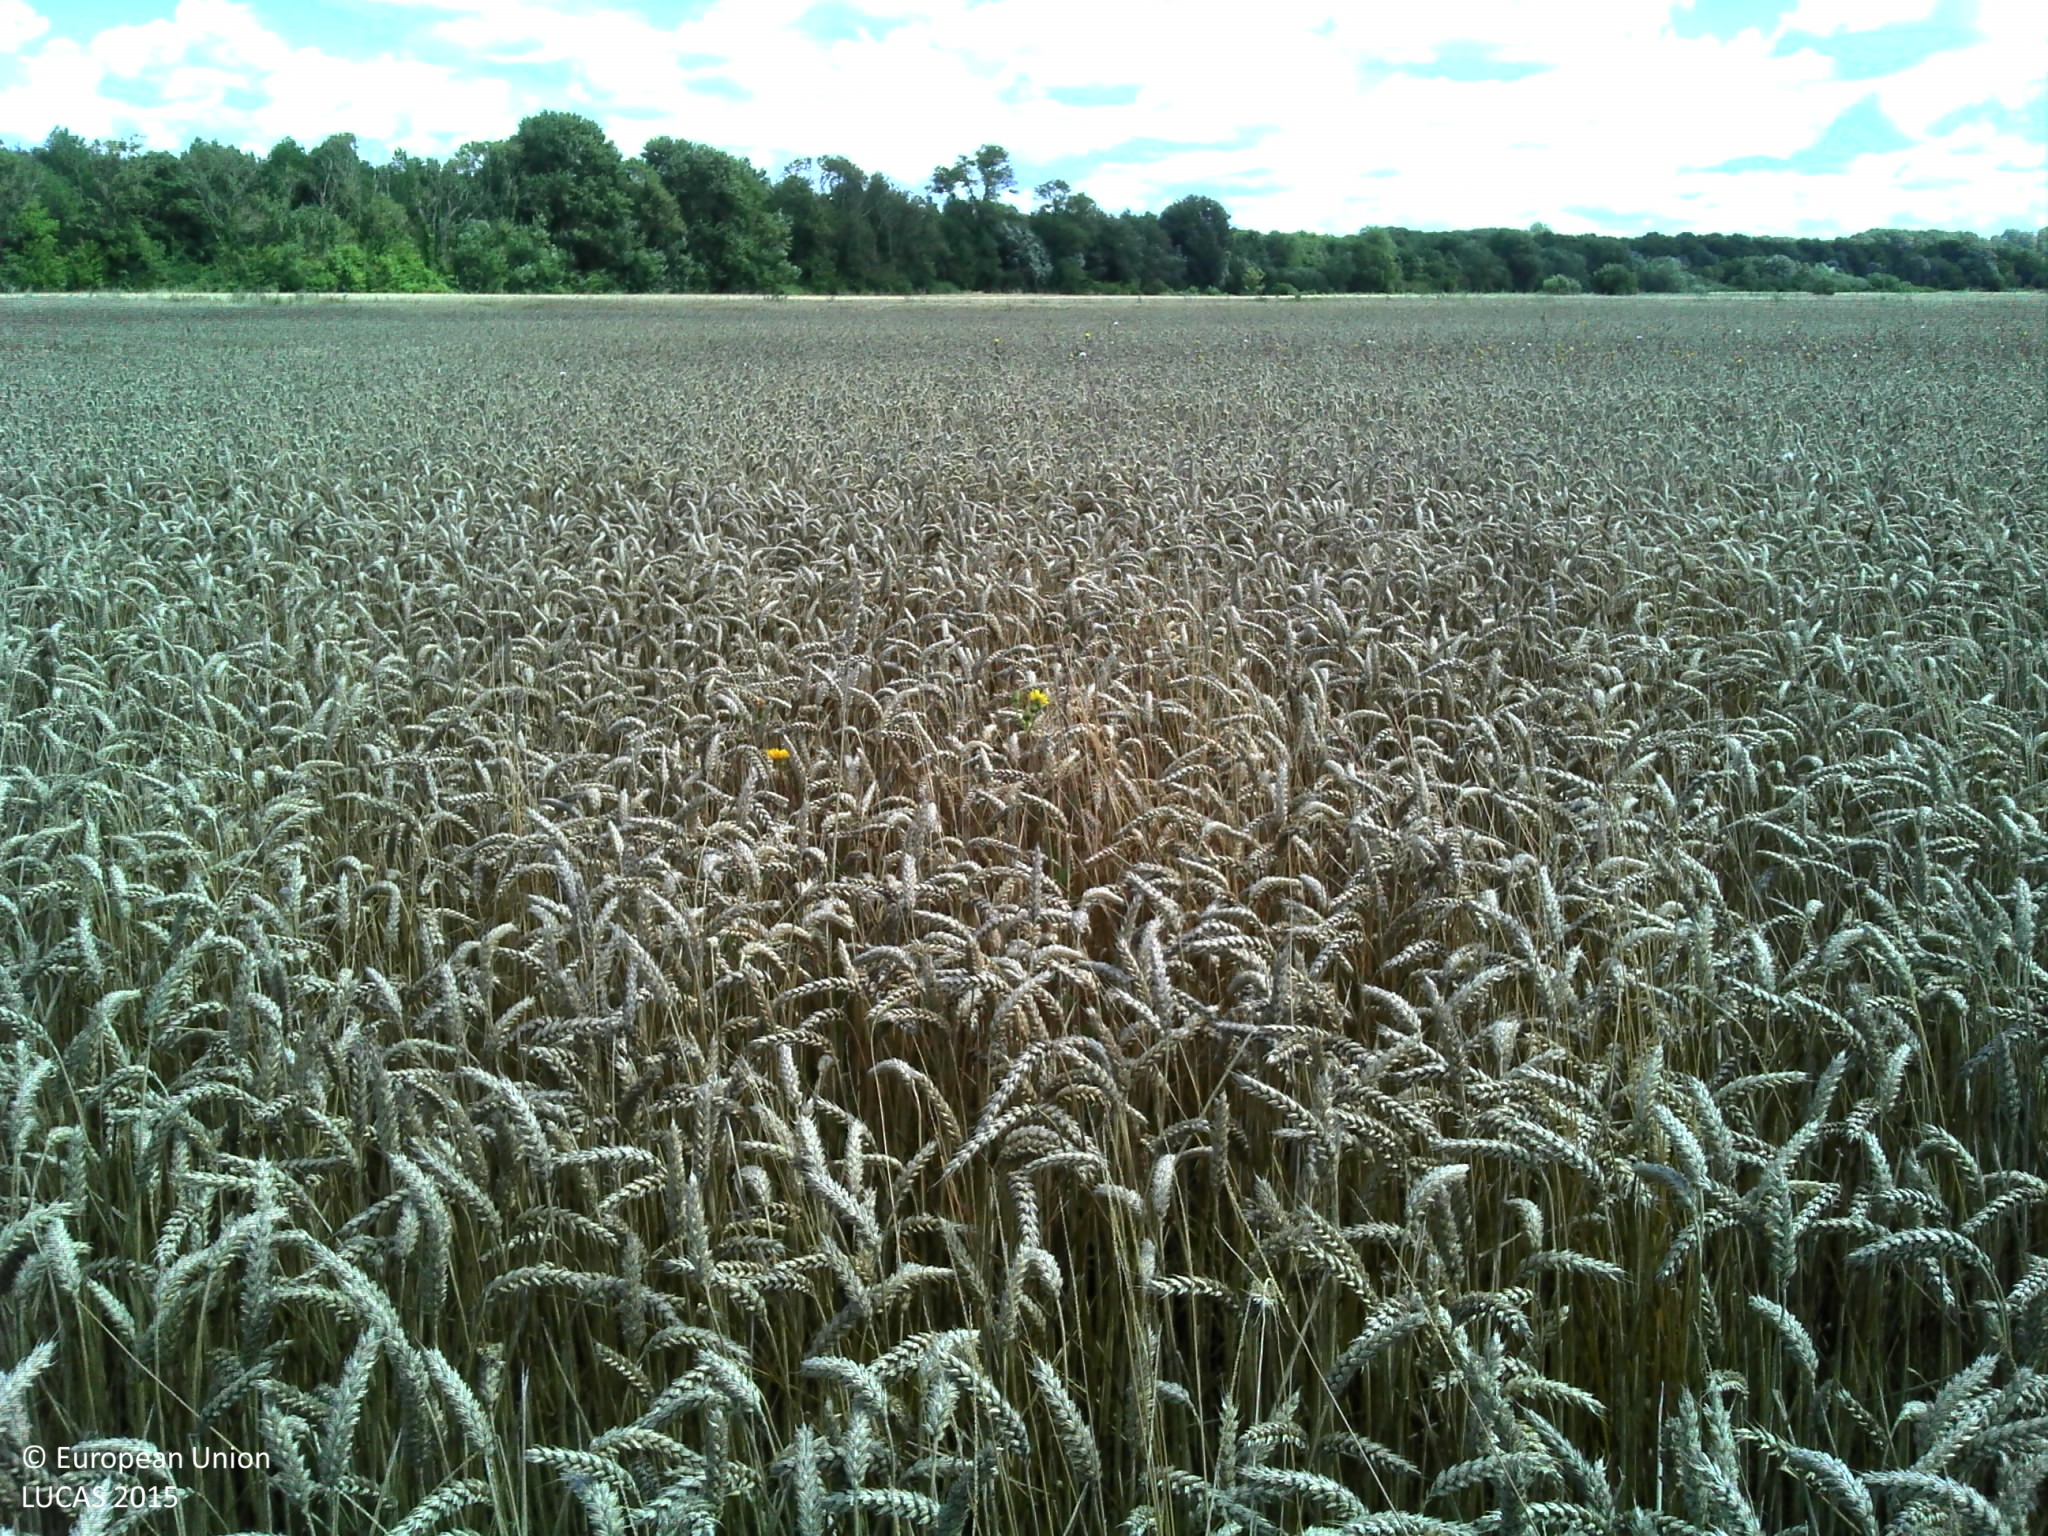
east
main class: Cropland
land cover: Common wheat
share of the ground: > 75 %
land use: Agriculture (excluding fallow land and kitchen gardens)
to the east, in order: Common wheat; Grass margins; Tracks; Grass margins; Ditches and canals; Grass margins; Common wheat
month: July
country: FR
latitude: 50.3475
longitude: 1.6485
